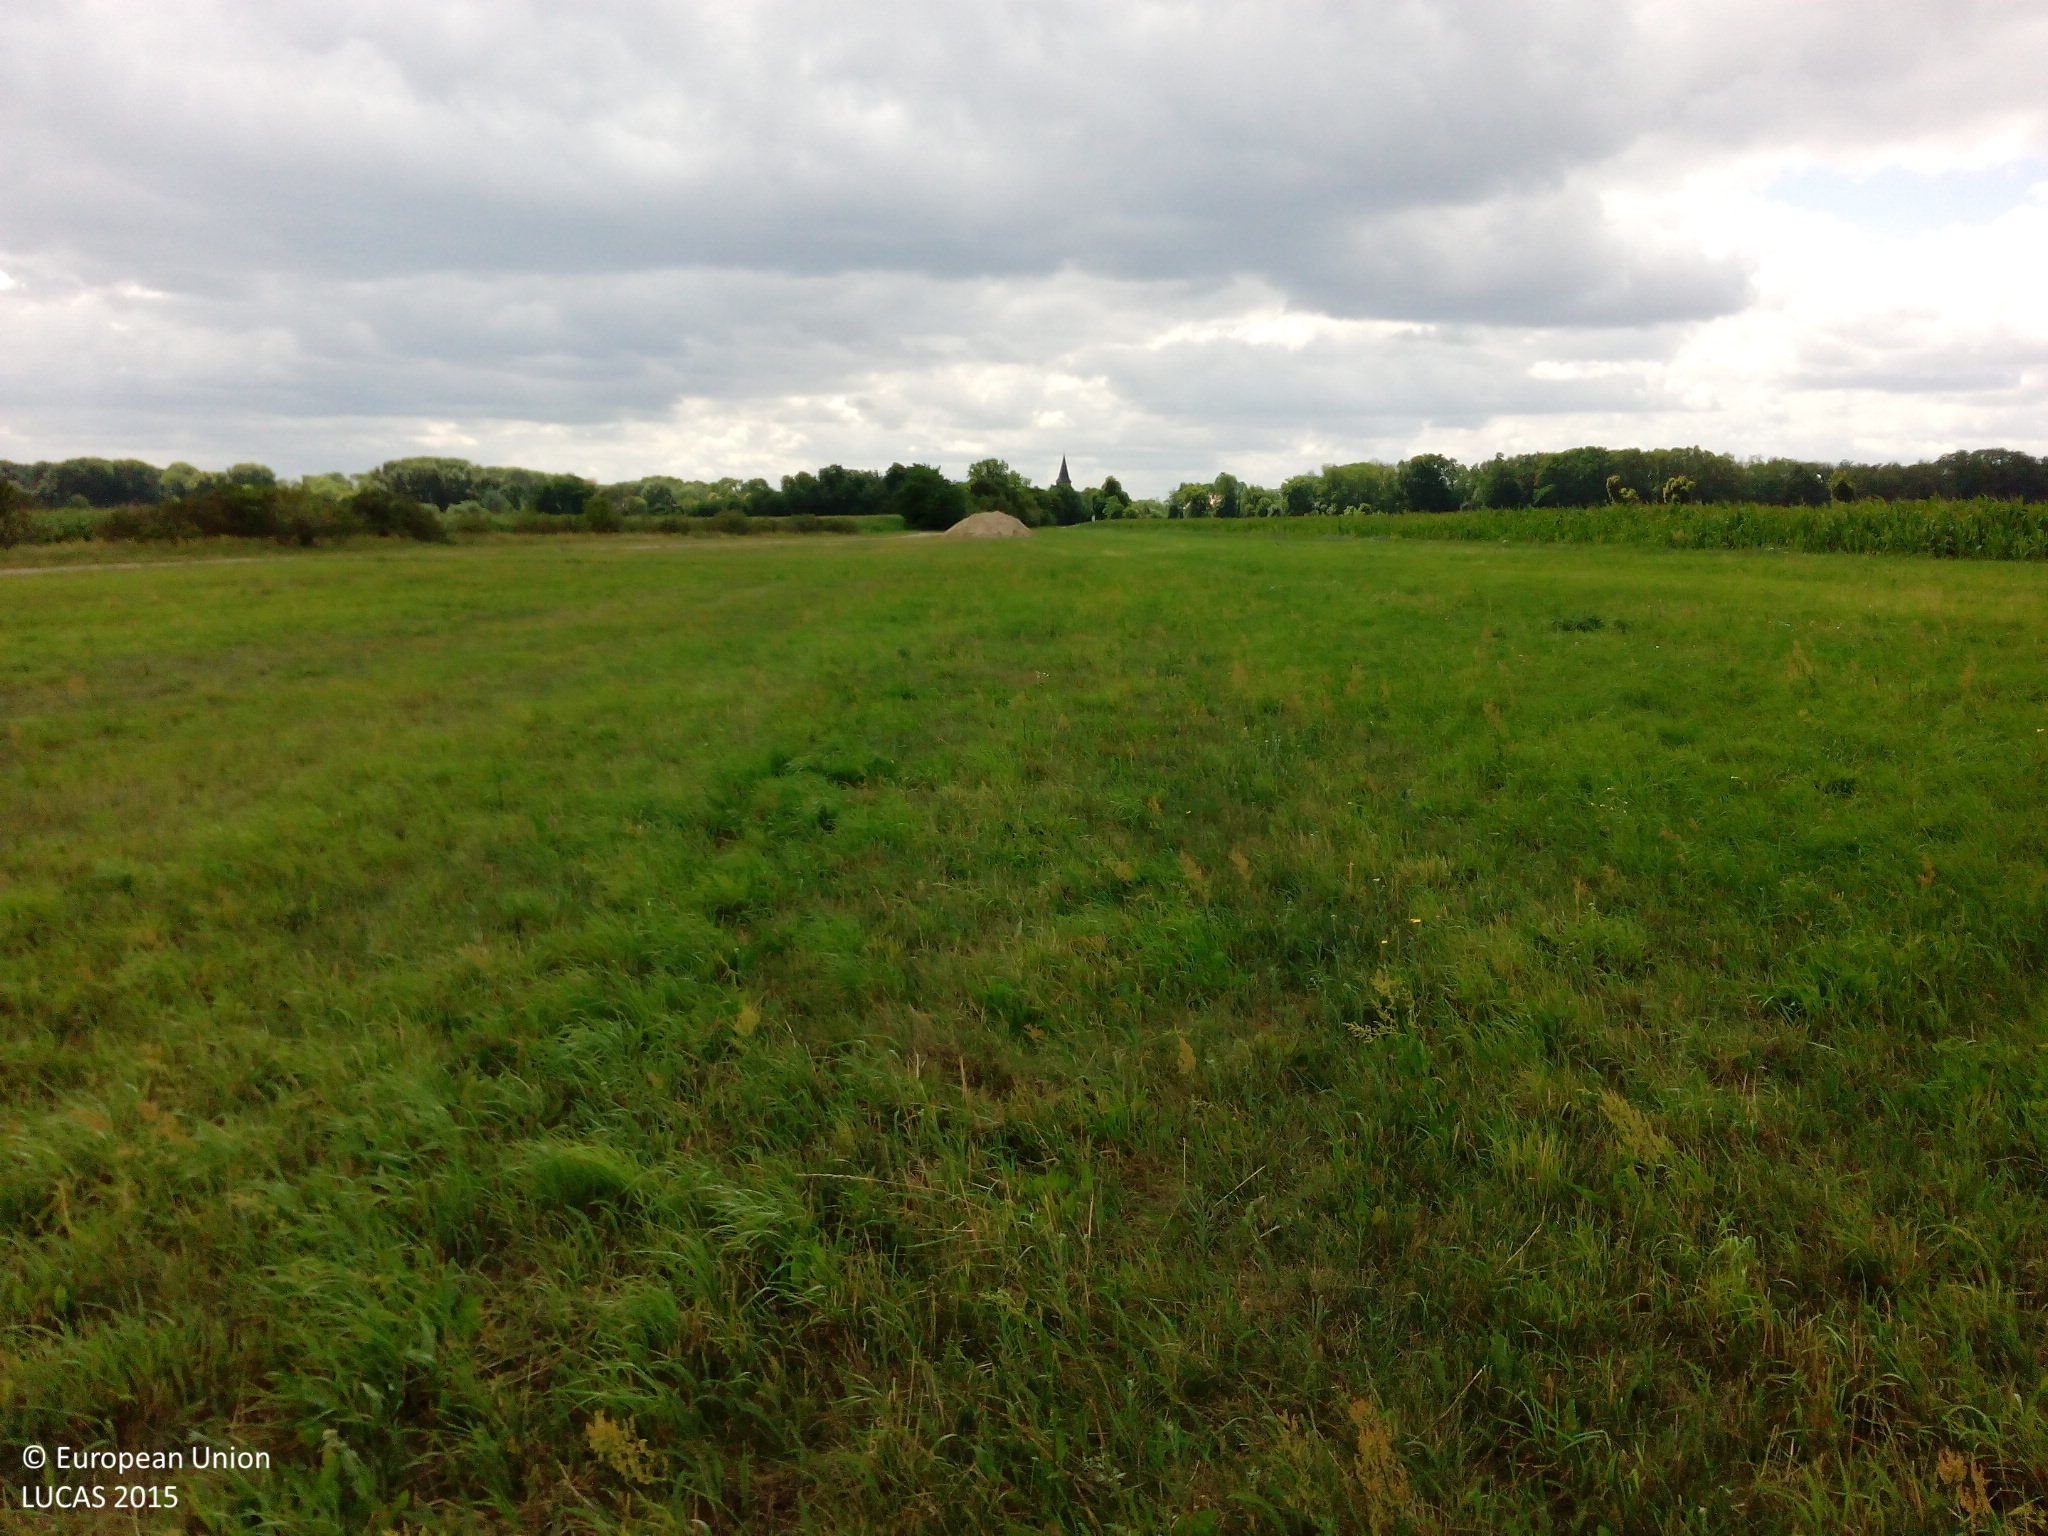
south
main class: Grassland
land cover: Grassland without tree/shrub cover
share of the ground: > 75 %
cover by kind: herbaceous plants 100 %
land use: Agriculture (excluding fallow land and kitchen gardens)
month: July
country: DE
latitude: 52.6827
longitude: 14.1576
